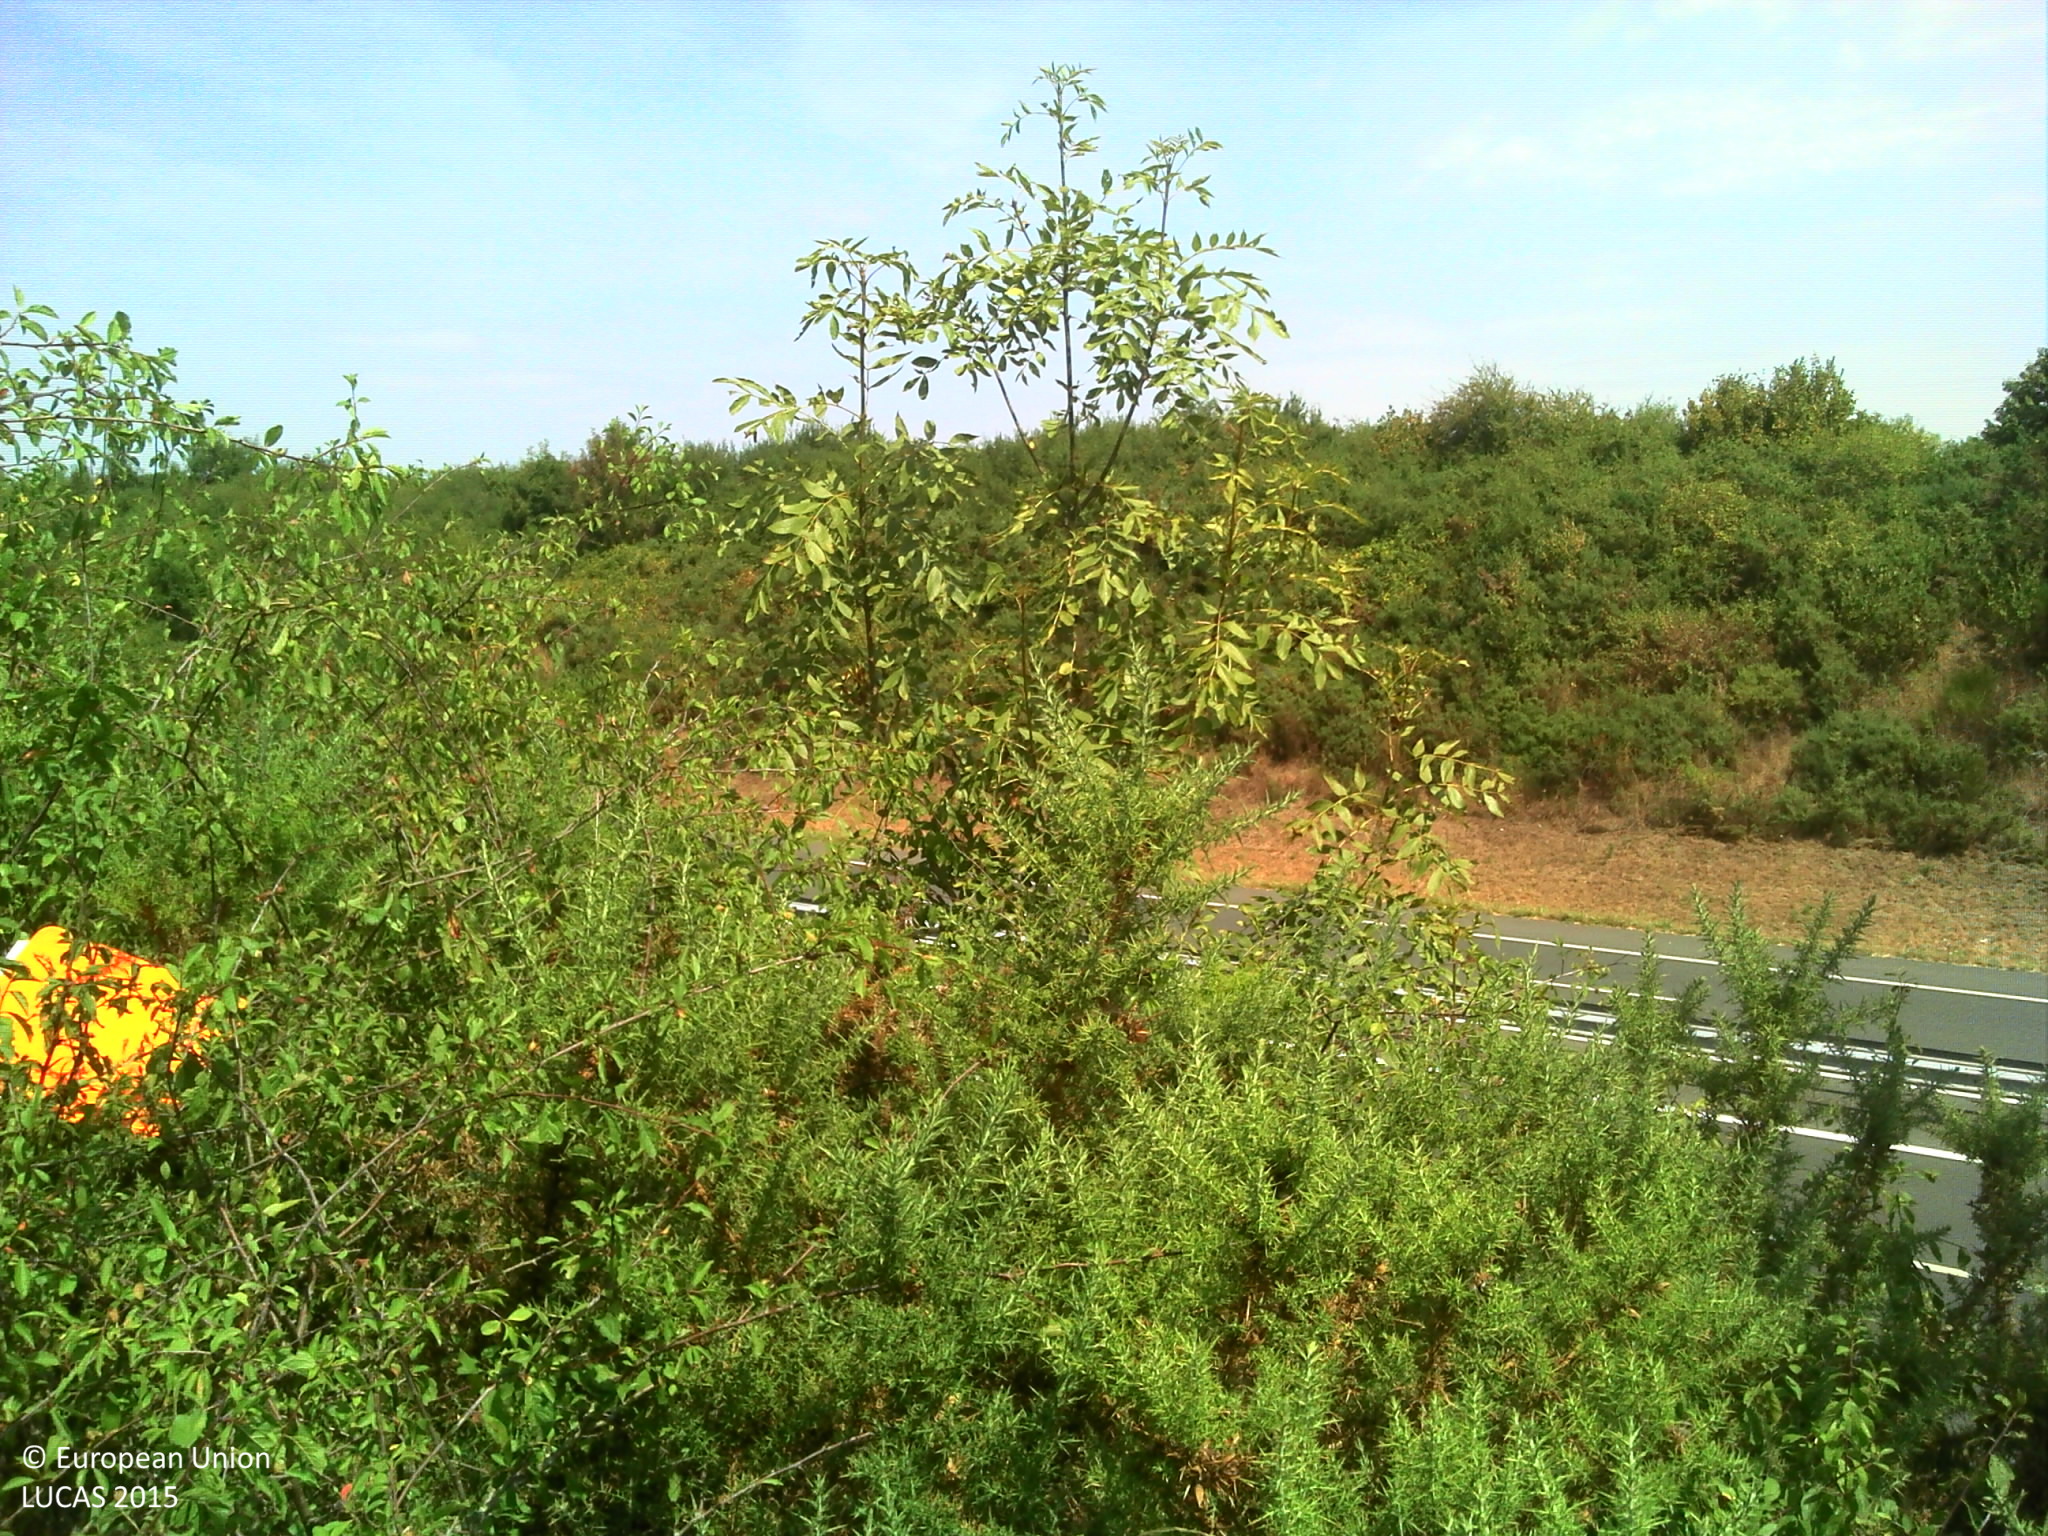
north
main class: Woodland
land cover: Broadleaved woodland
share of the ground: > 75 %
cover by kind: broadleaved forest trees 90 %, shrubs 10 %
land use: Road transport
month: August
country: FR
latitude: 46.6563
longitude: -1.1551
